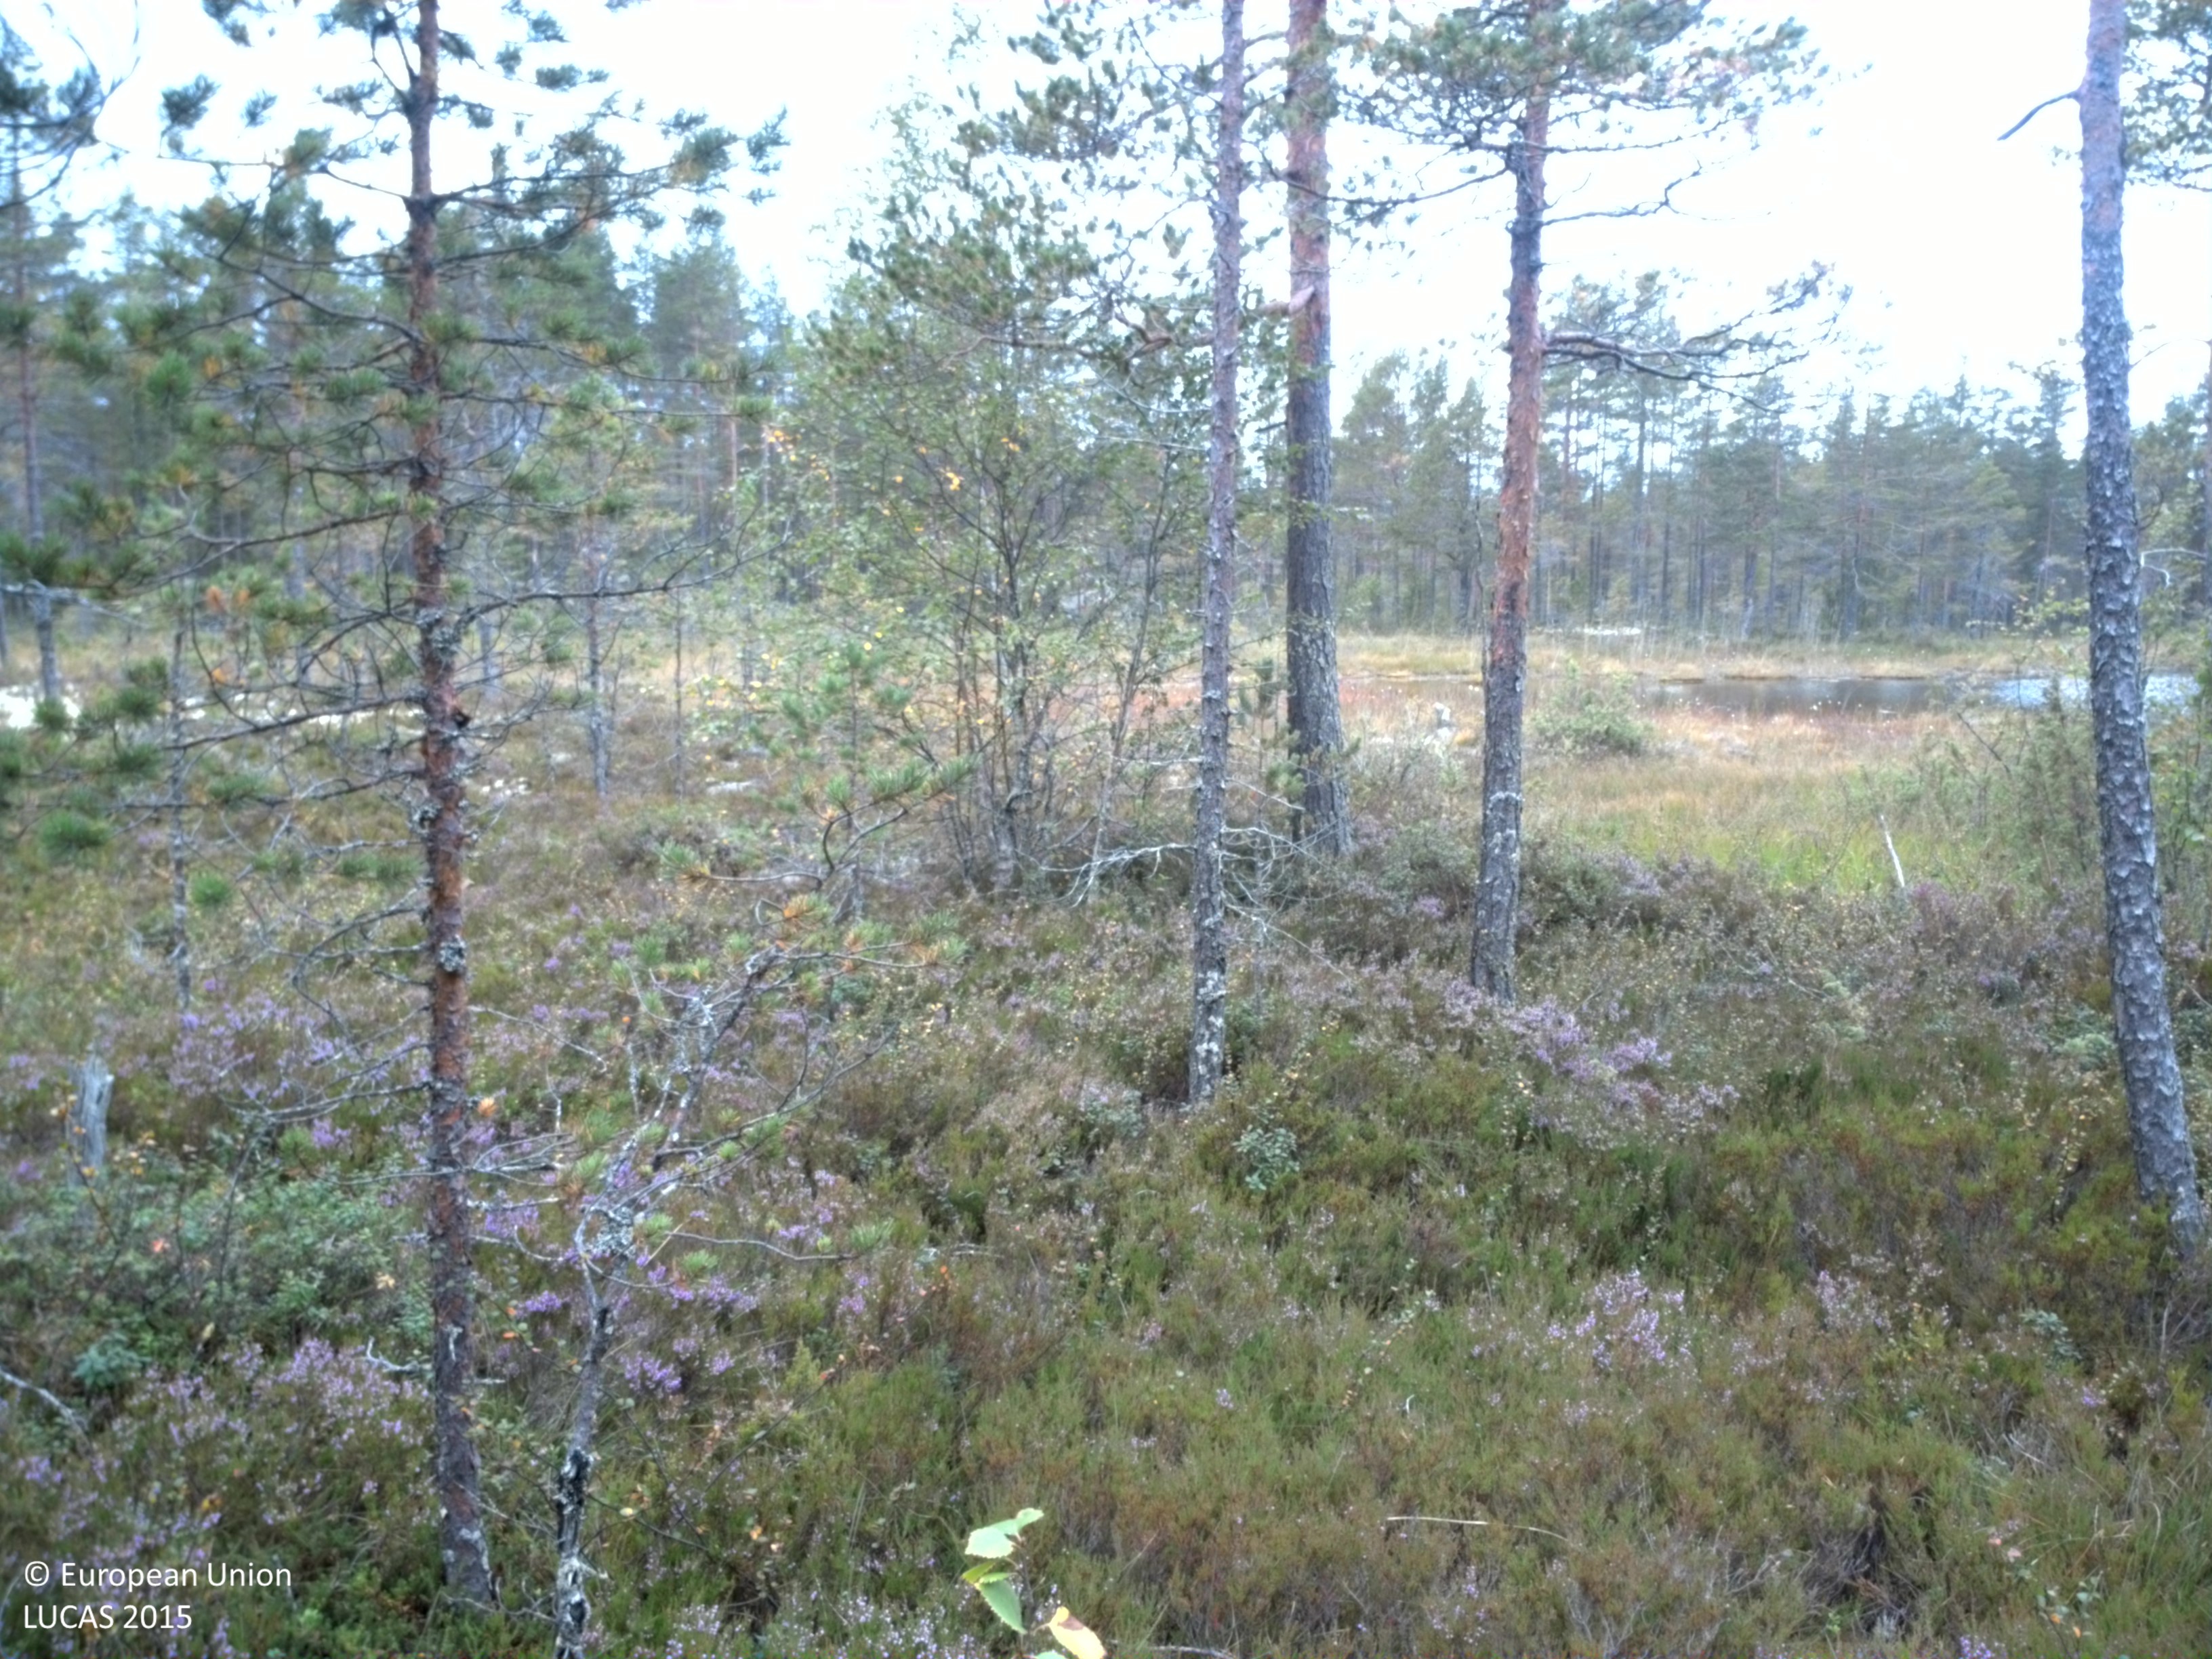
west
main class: Woodland
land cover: Pine dominated coniferous woodland
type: boreal forest
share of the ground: 25 - 50 %
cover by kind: coniferous forest trees 40 %, shrubs 40 %, lichens and mosses 15 %, broadleaved forest trees 5 %
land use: Forestry
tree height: > 5 m
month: August
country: SE
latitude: 61.6961
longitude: 15.0692
